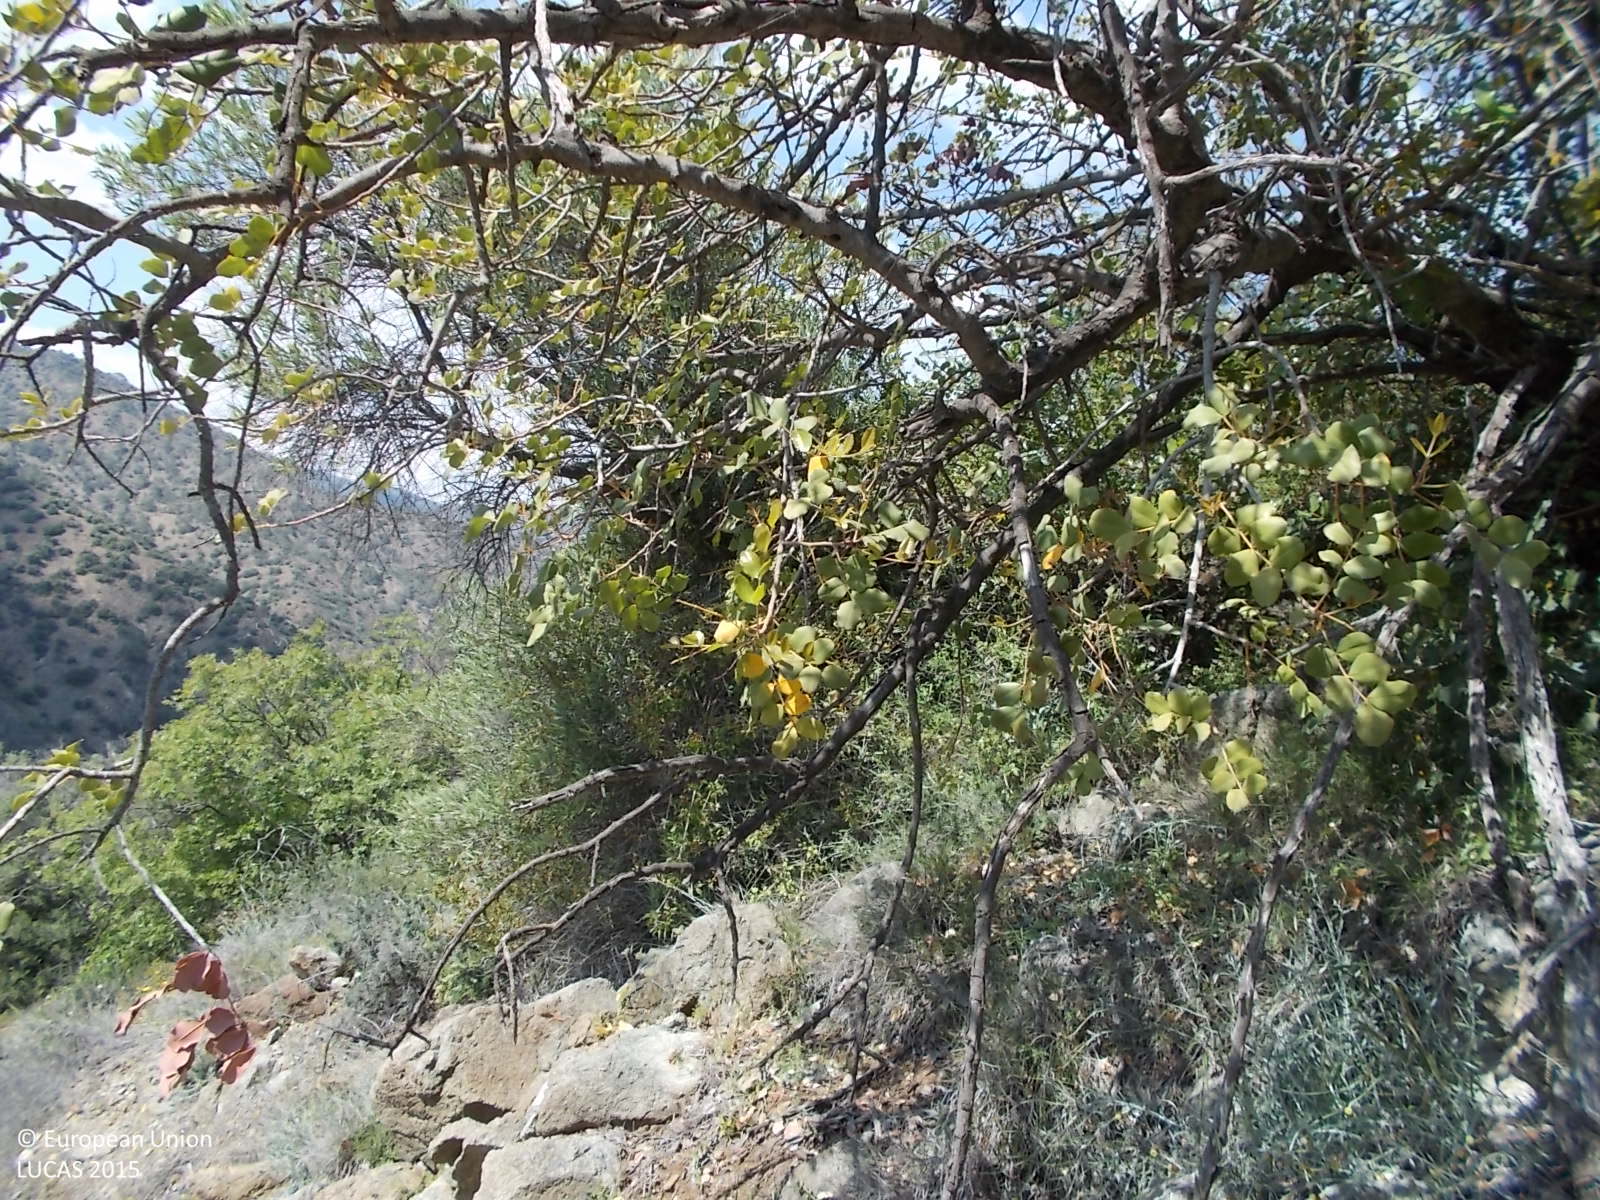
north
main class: Shrubland
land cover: Shrubland with sparse tree cover
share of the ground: > 75 %
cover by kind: shrubs 95 %, broadleaved forest trees 5 %
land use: Semi-natural and natural areas not in use
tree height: > 5 m
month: April
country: CY
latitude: 34.7674
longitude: 33.1036
